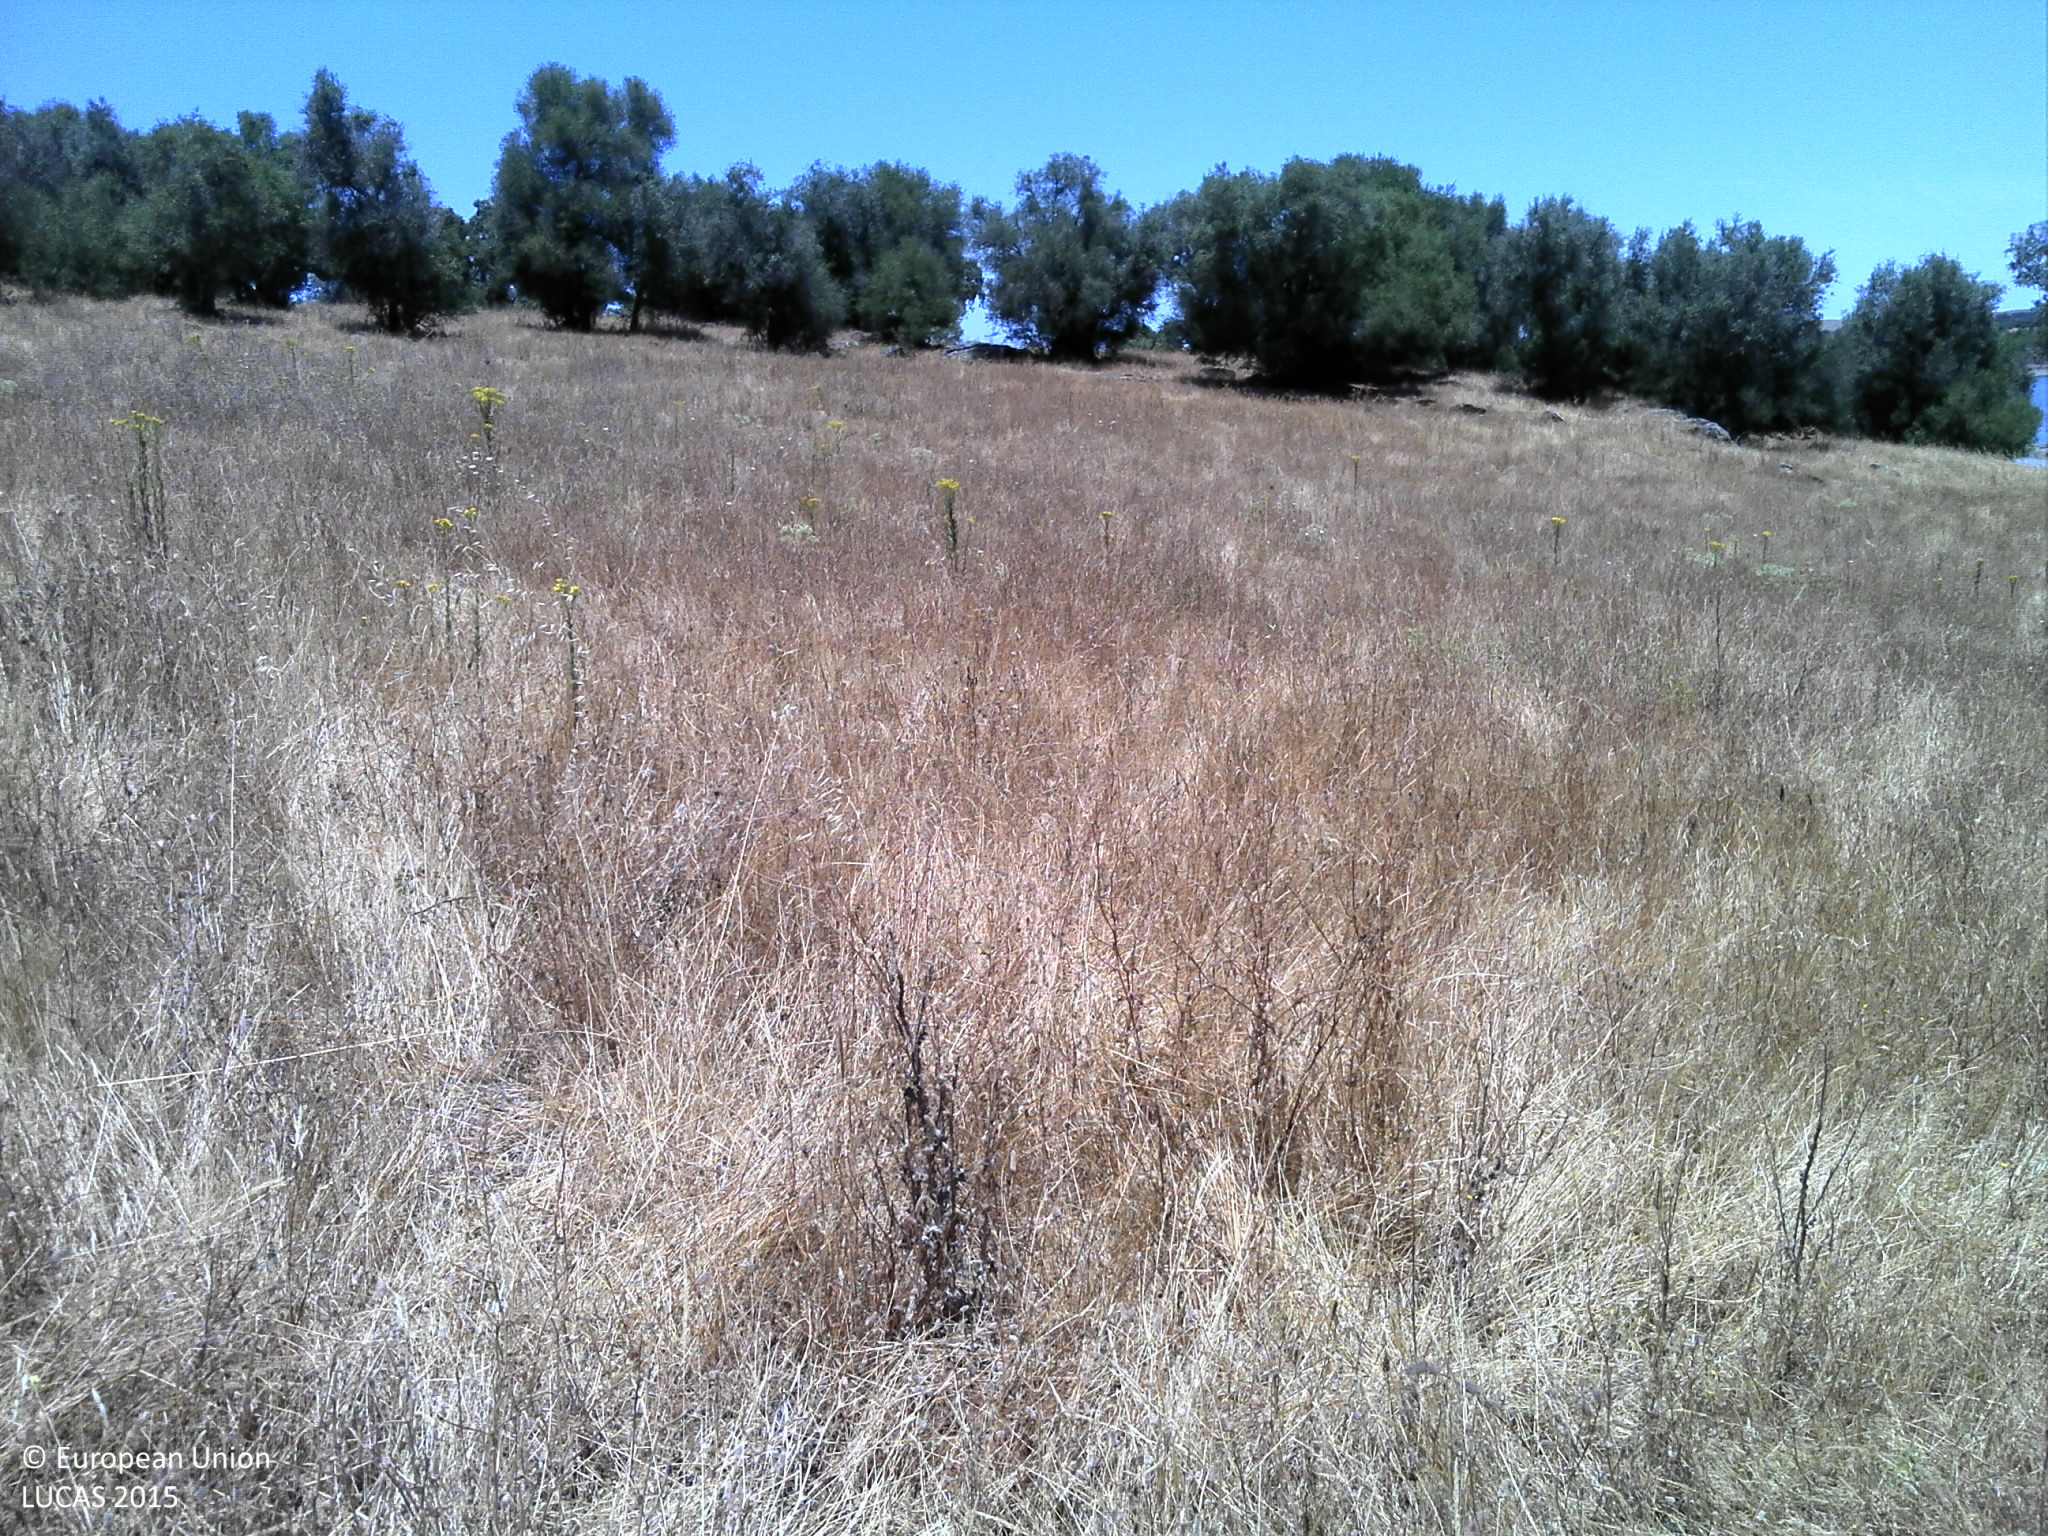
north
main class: Grassland
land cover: Grassland with sparse tree/shrub cover
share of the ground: 50 - 75 %
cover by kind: herbaceous plants 50 %, consolidated bare surface 45 %, broadleaved forest trees 5 %
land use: Agriculture (excluding fallow land and kitchen gardens)
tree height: > 5 m
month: July
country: PT
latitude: 37.7180
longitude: -8.2852
